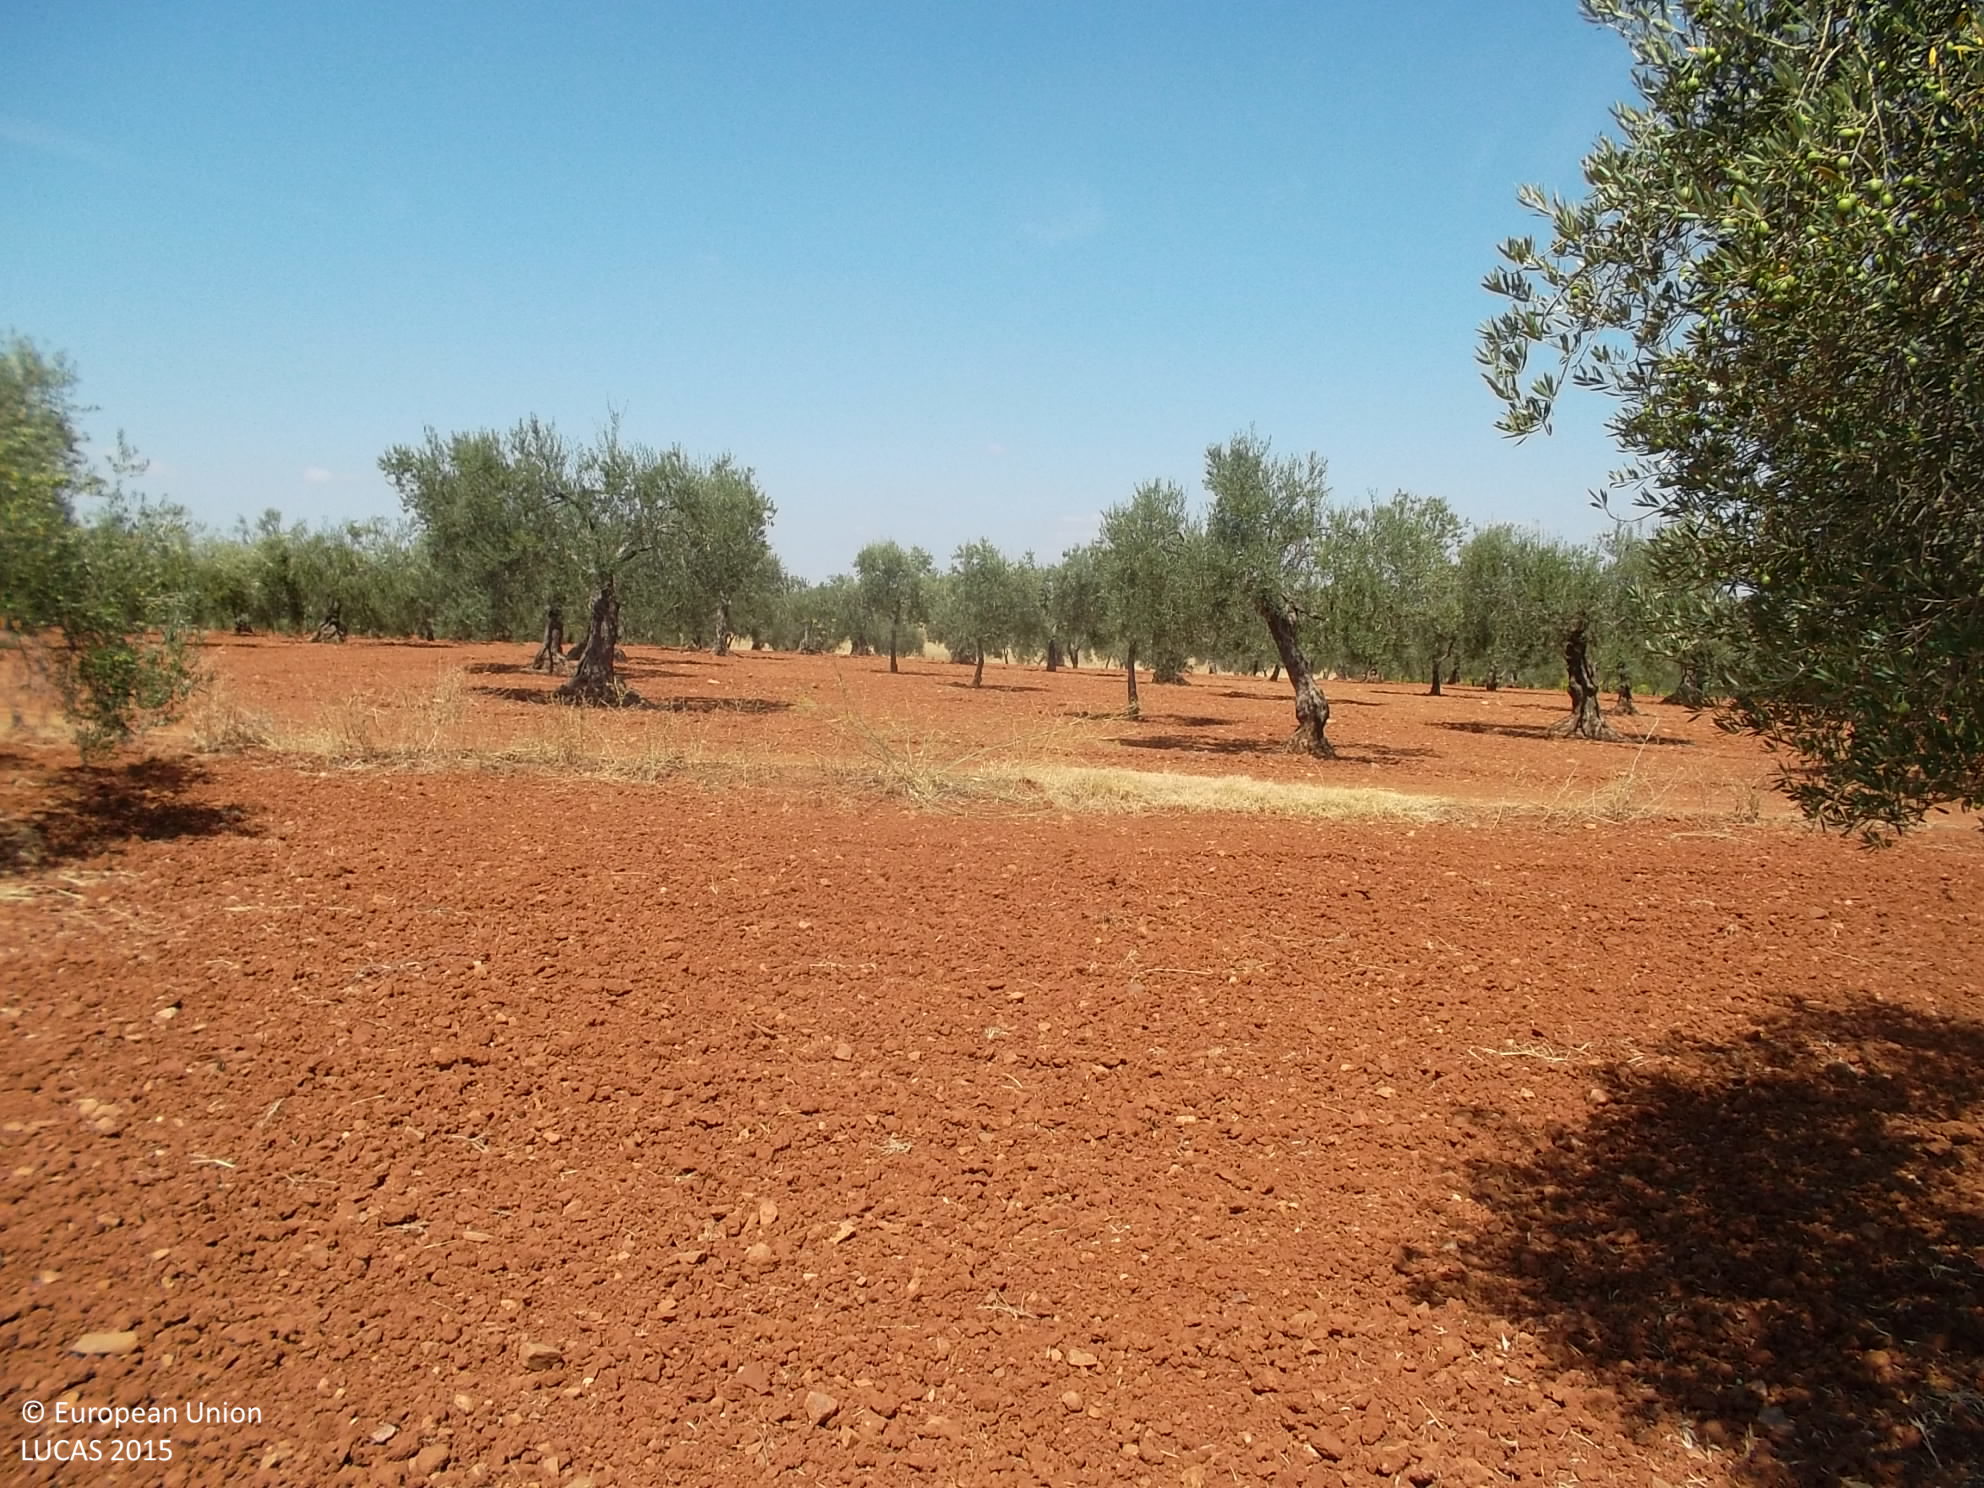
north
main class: Cropland
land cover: Olive groves
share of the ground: 10 - 25 %
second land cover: Other bare soil
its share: > 75 %
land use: Agriculture (excluding fallow land and kitchen gardens)
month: September
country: ES
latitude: 38.3680
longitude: -6.3580
